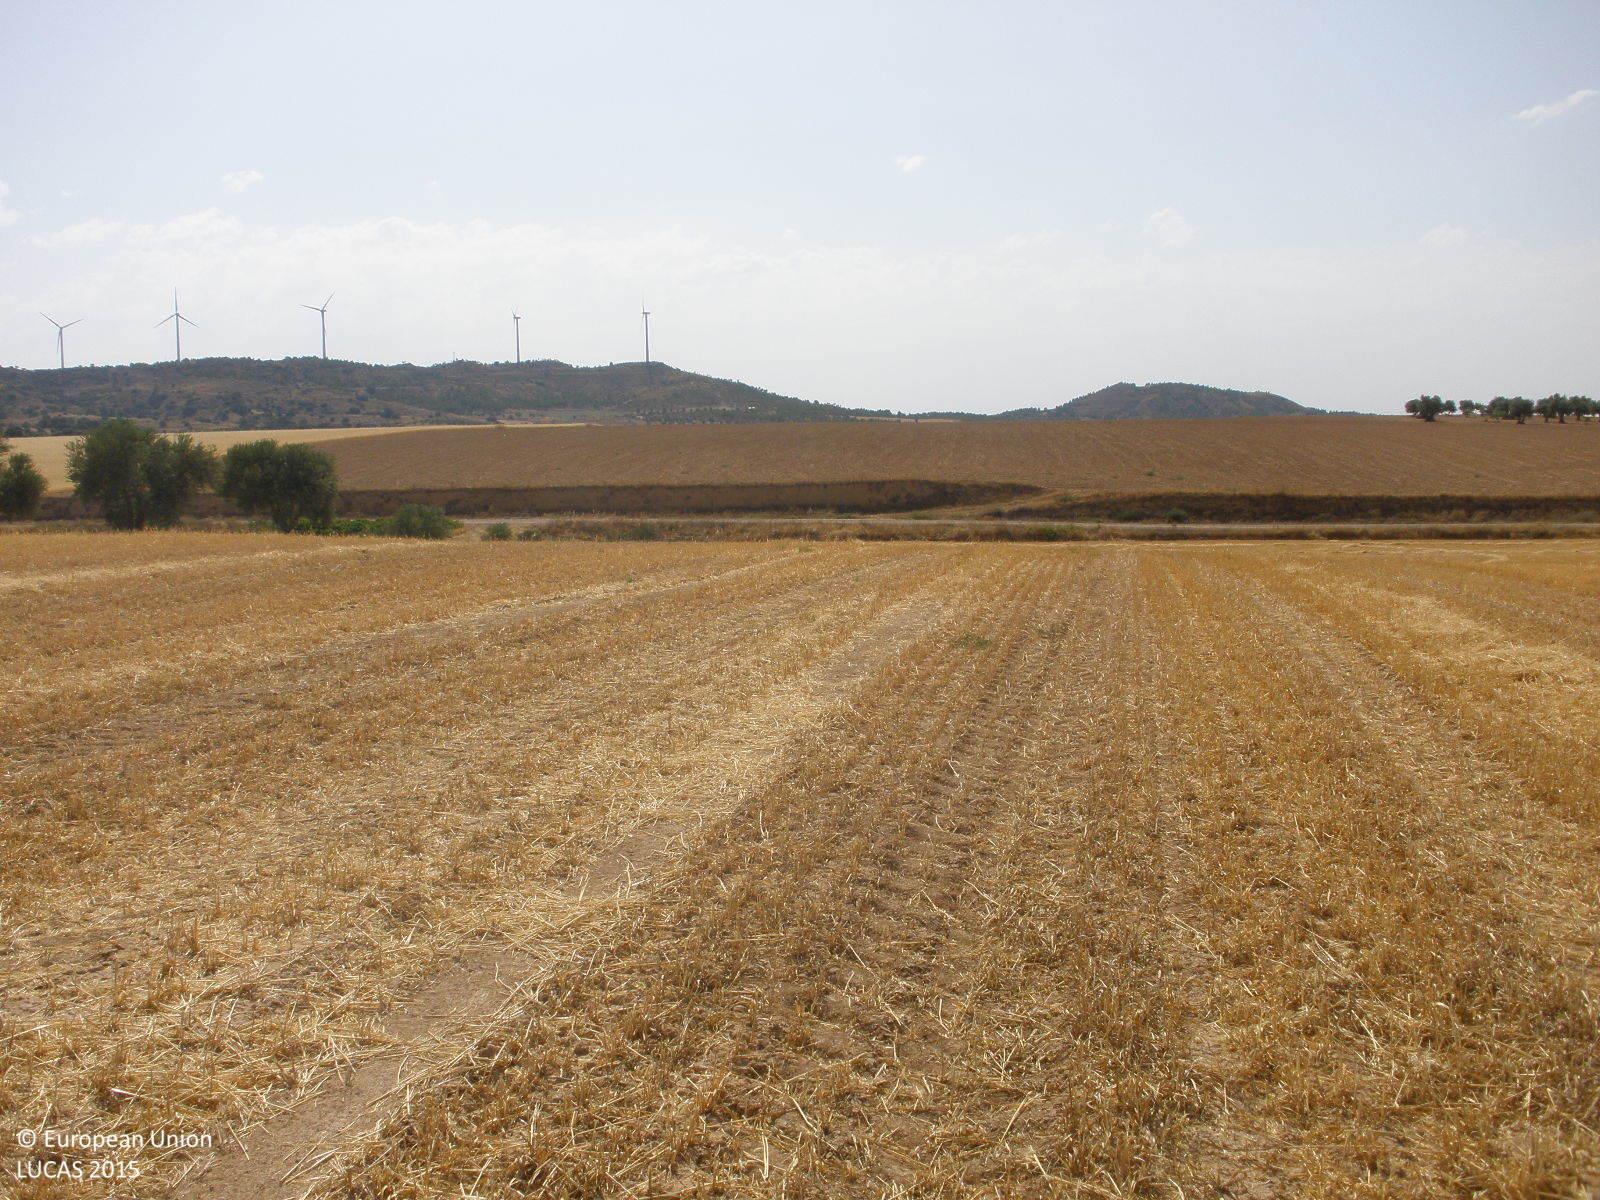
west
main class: Cropland
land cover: Barley
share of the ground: < 10 %
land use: Agriculture (excluding fallow land and kitchen gardens)
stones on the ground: < 10 %
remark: Harvested field
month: July
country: ES
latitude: 40.0132
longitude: -3.3246
